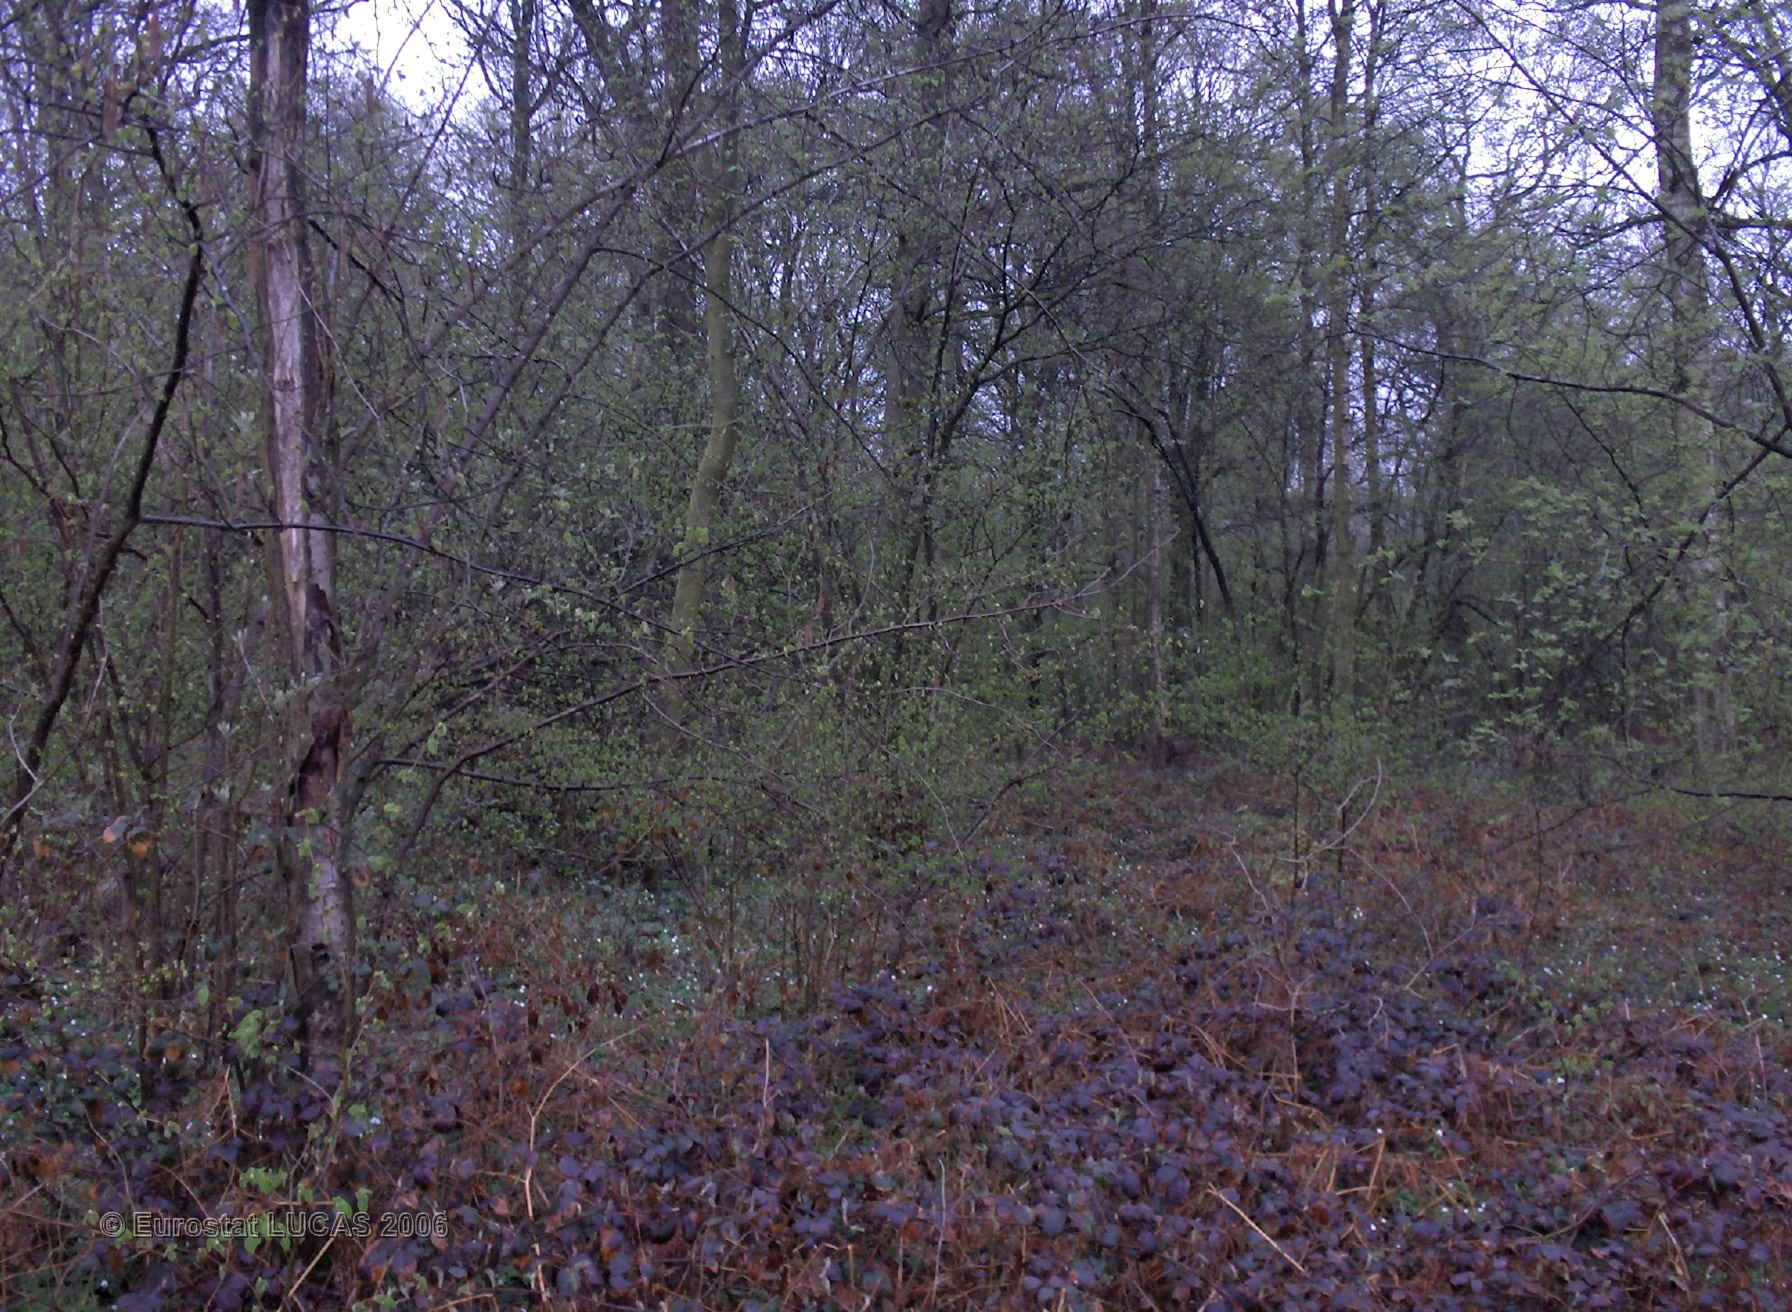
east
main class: Woodland
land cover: Mixed forest
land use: Forestry
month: April
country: BE
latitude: 50.3082
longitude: 4.5902
